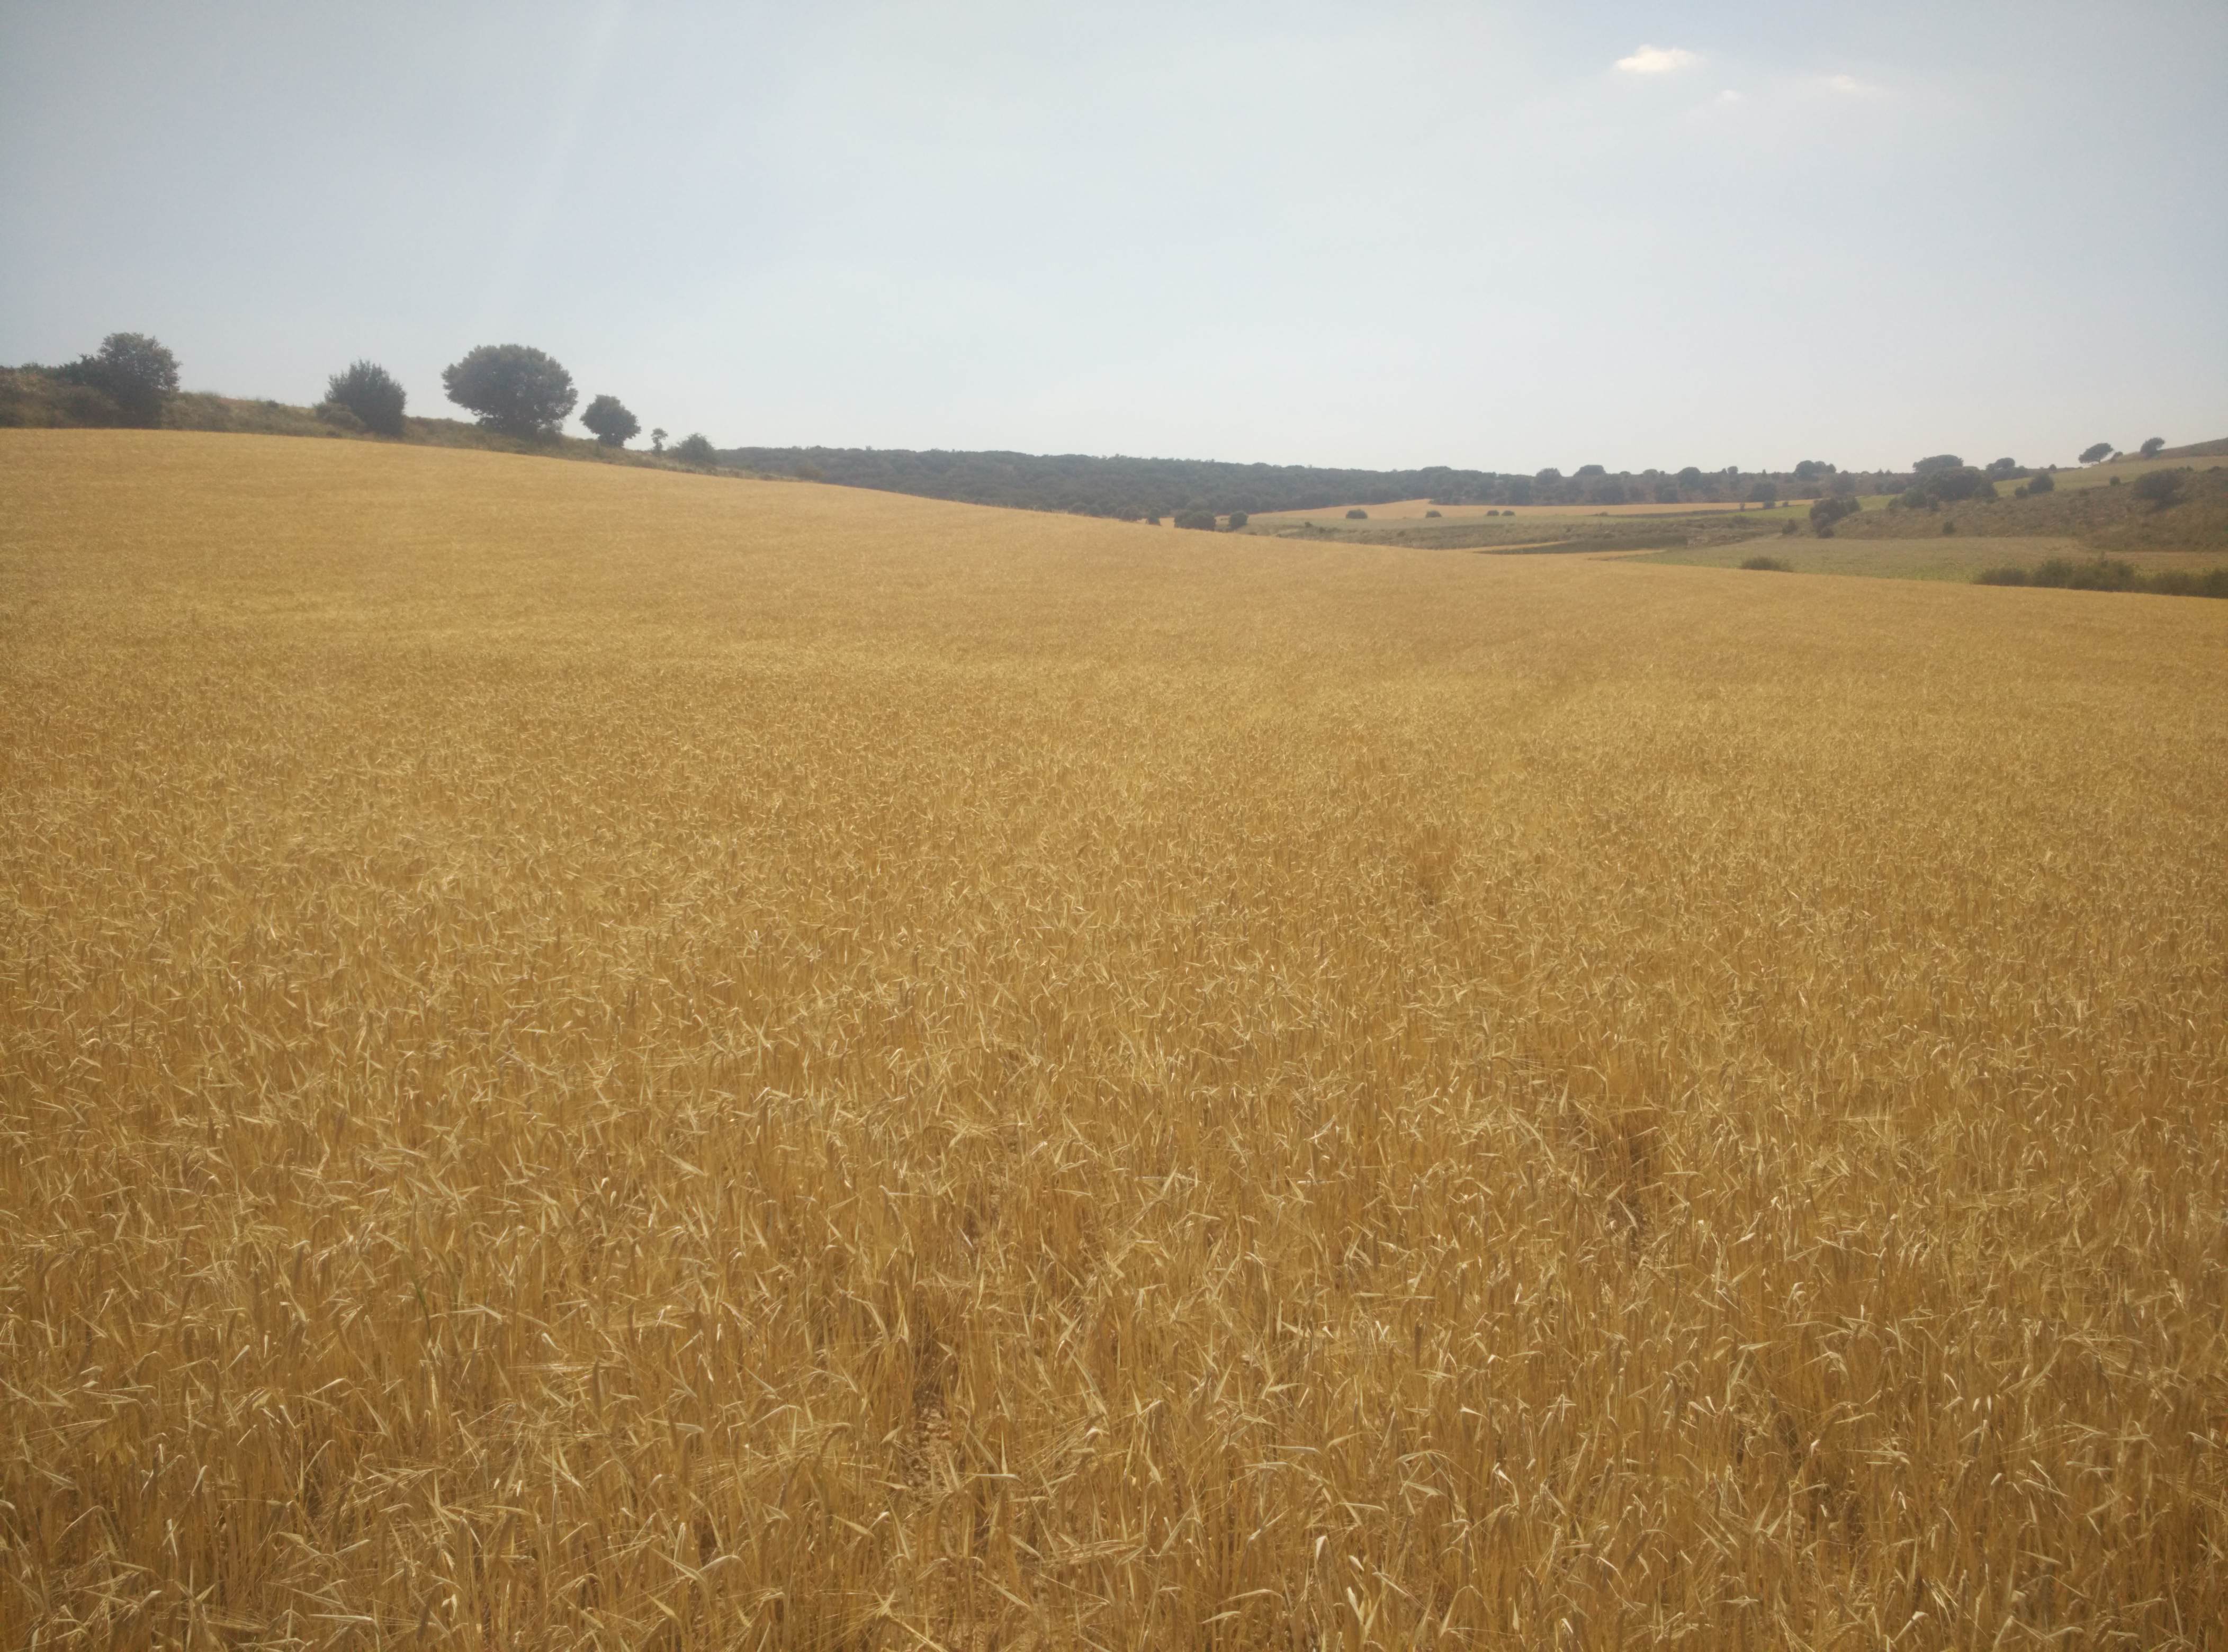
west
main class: Cropland
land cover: Barley
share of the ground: > 75 %
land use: Agriculture (excluding fallow land and kitchen gardens)
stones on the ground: 25 - 50 %
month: June
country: ES
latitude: 40.7541
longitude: -1.8298
